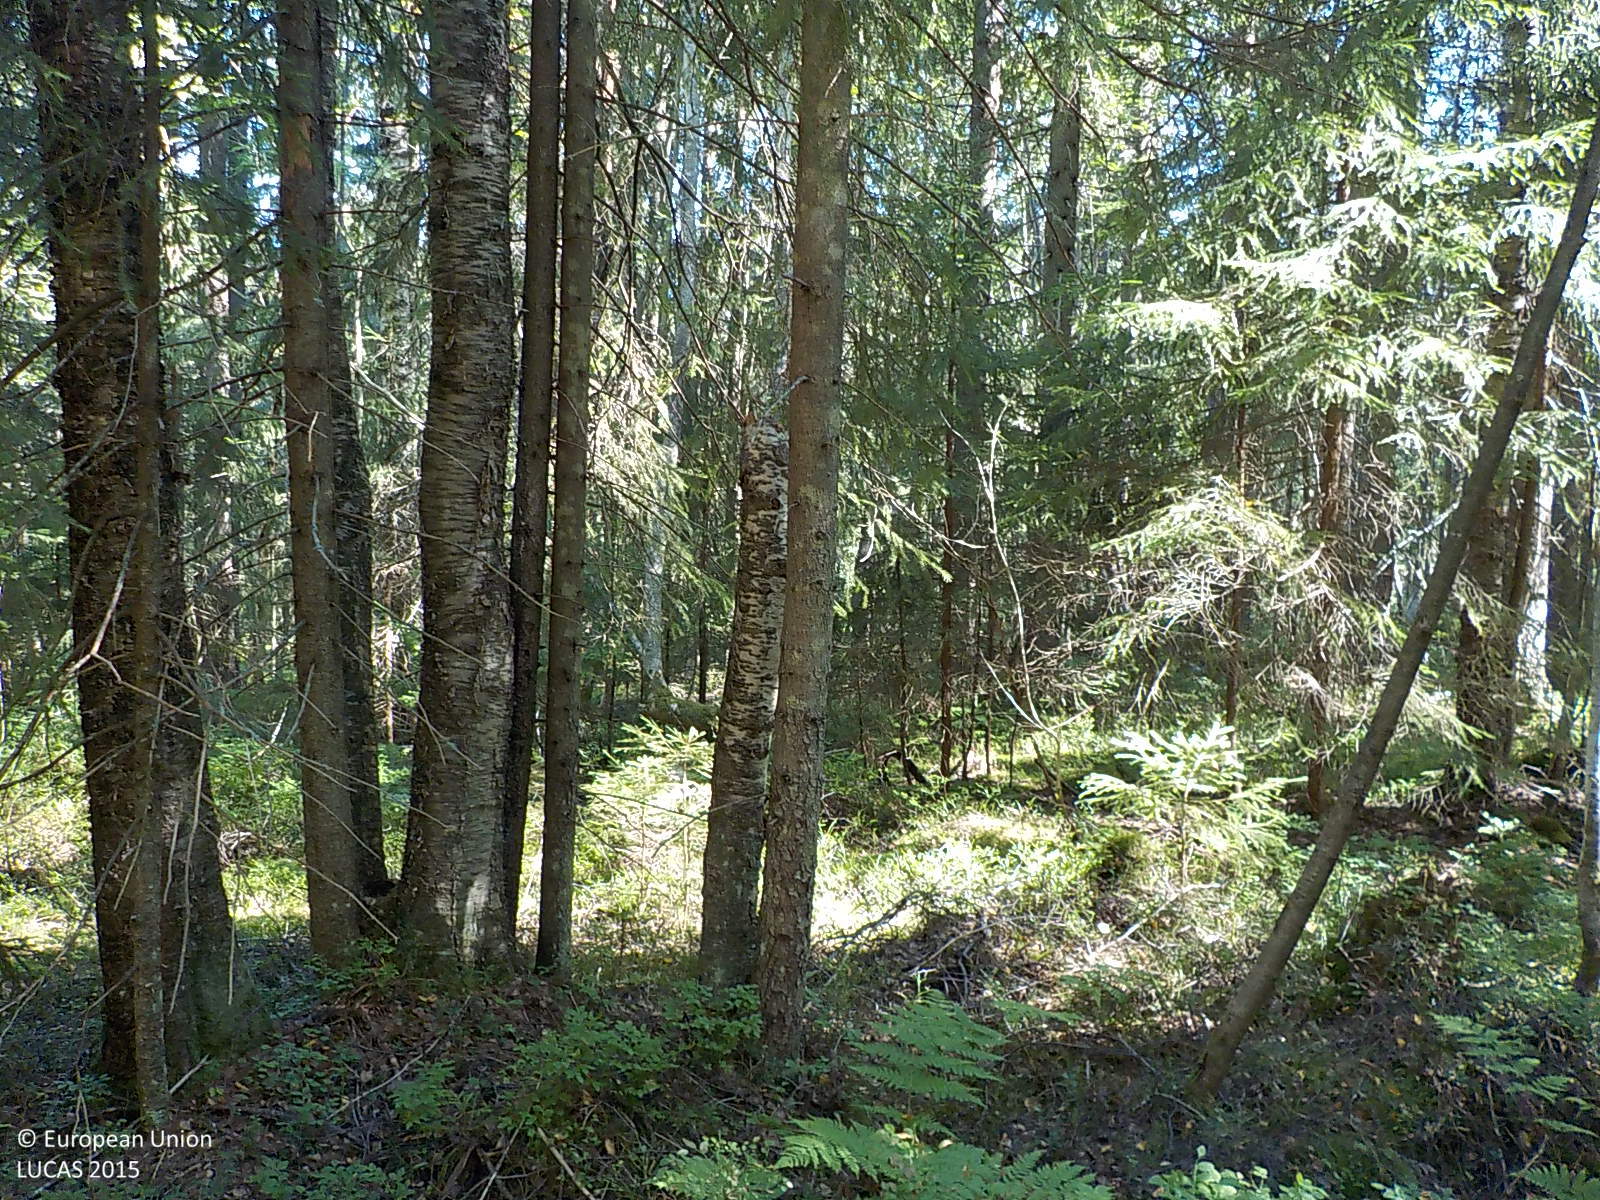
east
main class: Woodland
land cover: Spruce dominated coniferous woodland
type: boreal forest
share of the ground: > 75 %
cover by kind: coniferous forest trees 75 %, herbaceous plants 25 %
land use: Forestry
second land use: Amenities, museums, leisure
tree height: > 5 m
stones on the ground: 10 - 25 %
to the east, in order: Spruce dominated coniferous woodland; Tracks; Spruce dominated coniferous woodland; Tracks; Spruce dominated coniferous woodland; Electric lines; Broadleaved woodland; Paved roads, cycling and walking lanes; Broadleaved woodland
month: August
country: SE
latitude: 63.3050
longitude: 18.6971
